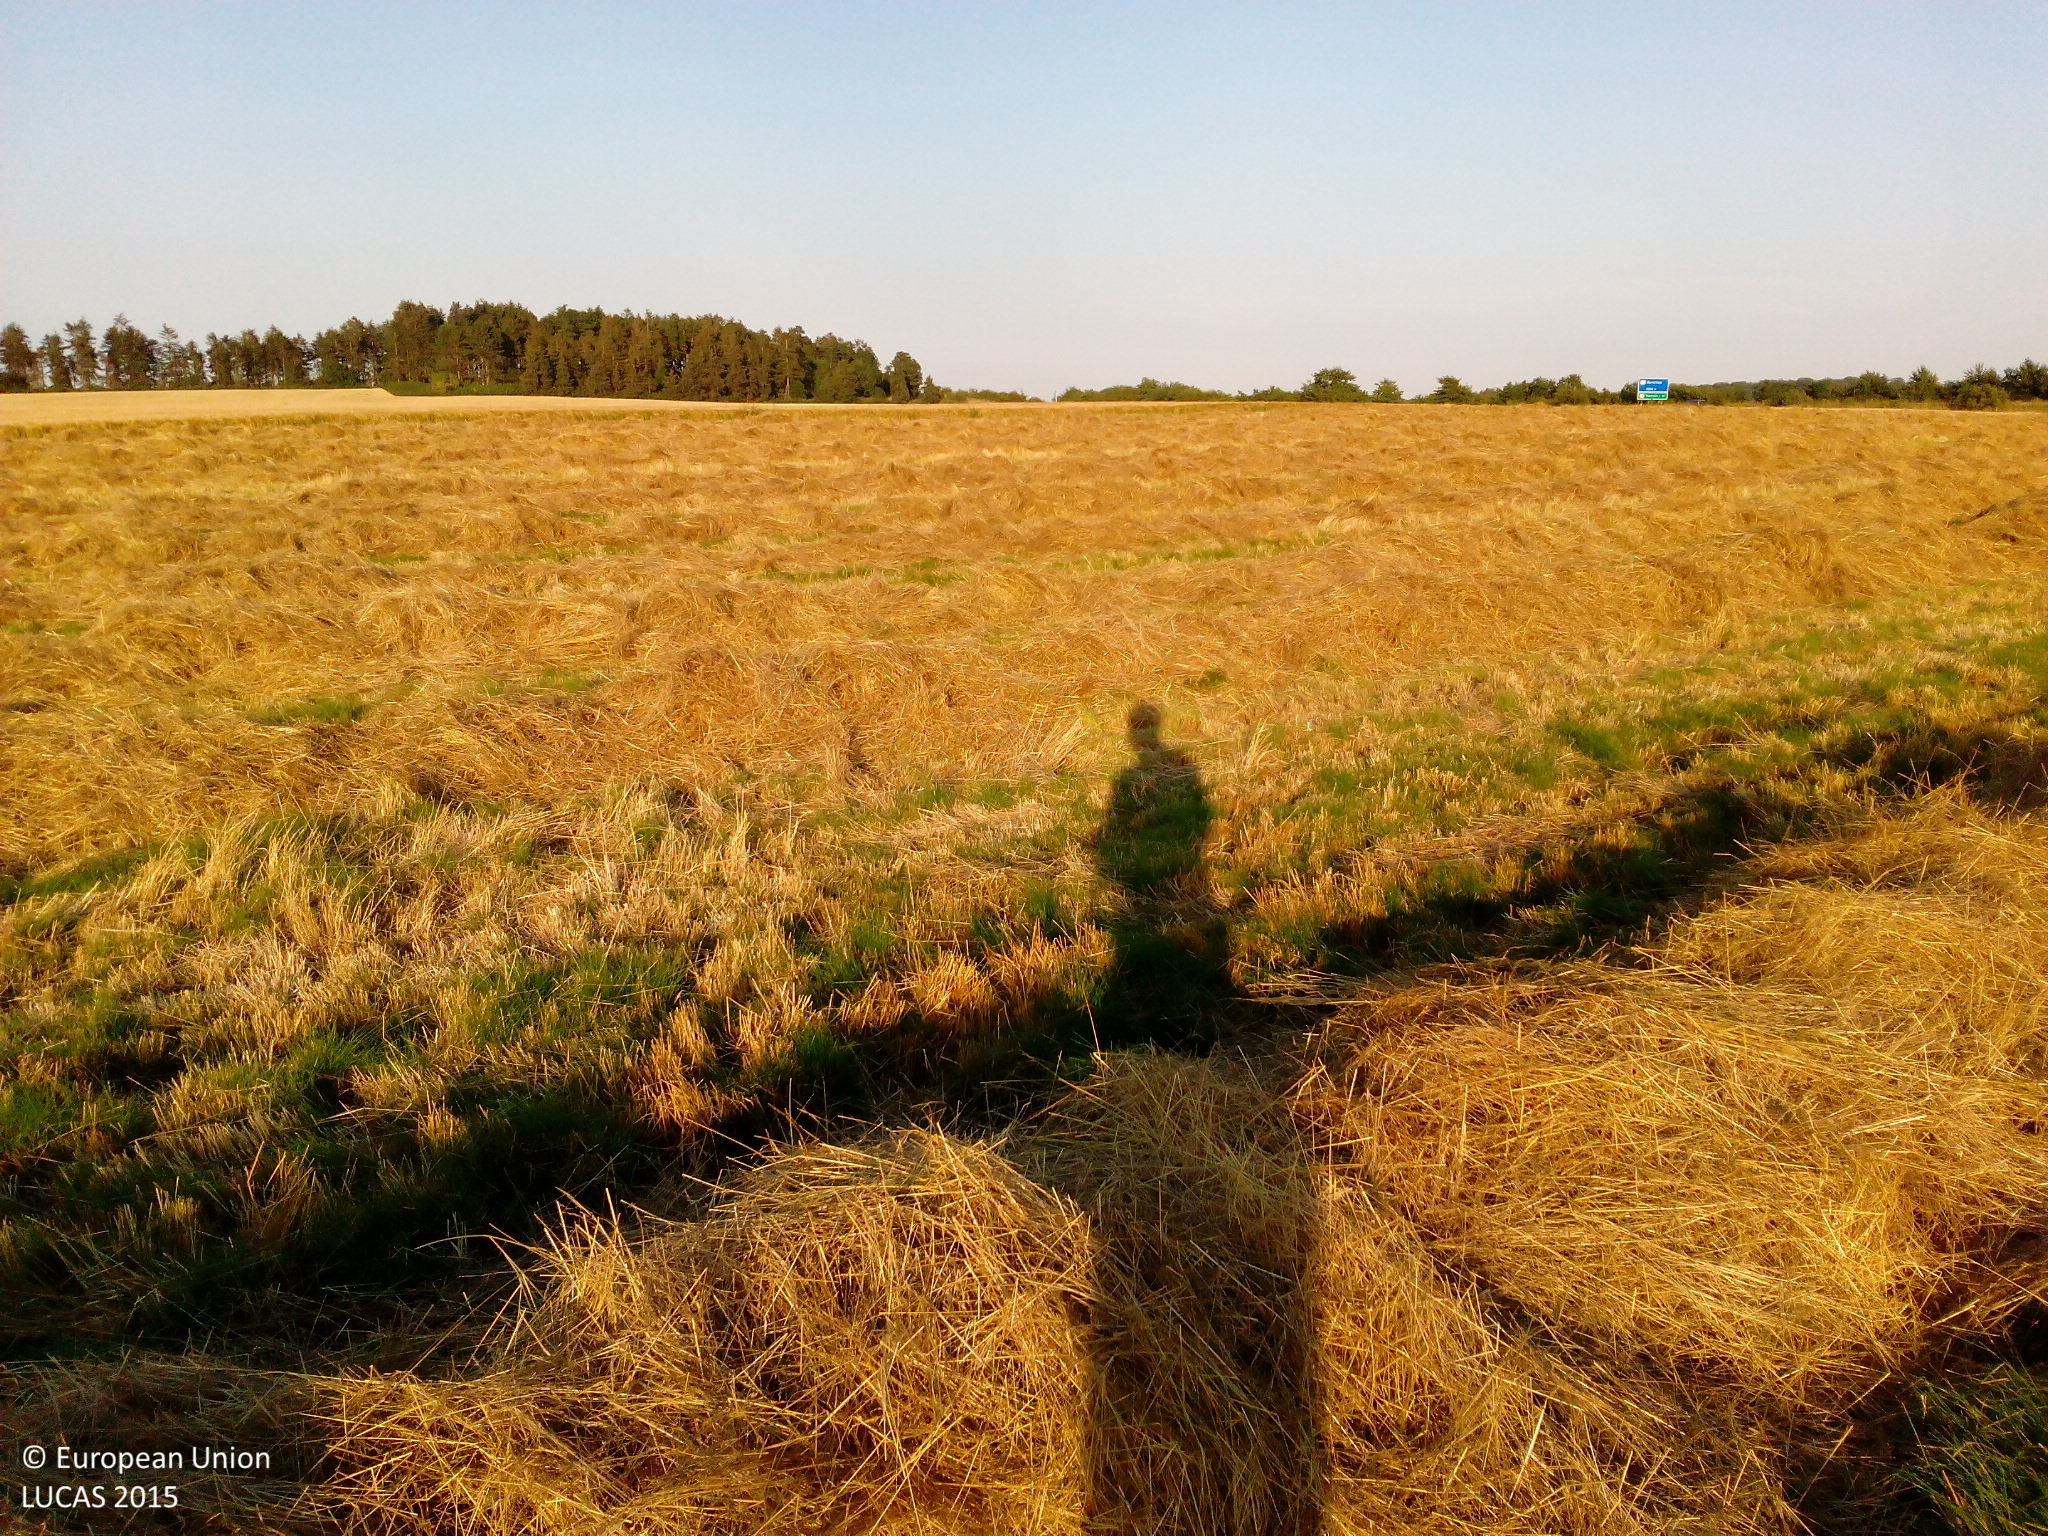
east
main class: Cropland
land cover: Temporary grasslands
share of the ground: > 75 %
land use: Agriculture (excluding fallow land and kitchen gardens)
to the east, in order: Temporary grasslands; Barley
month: August
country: DK
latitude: 55.6524
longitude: 11.8895
